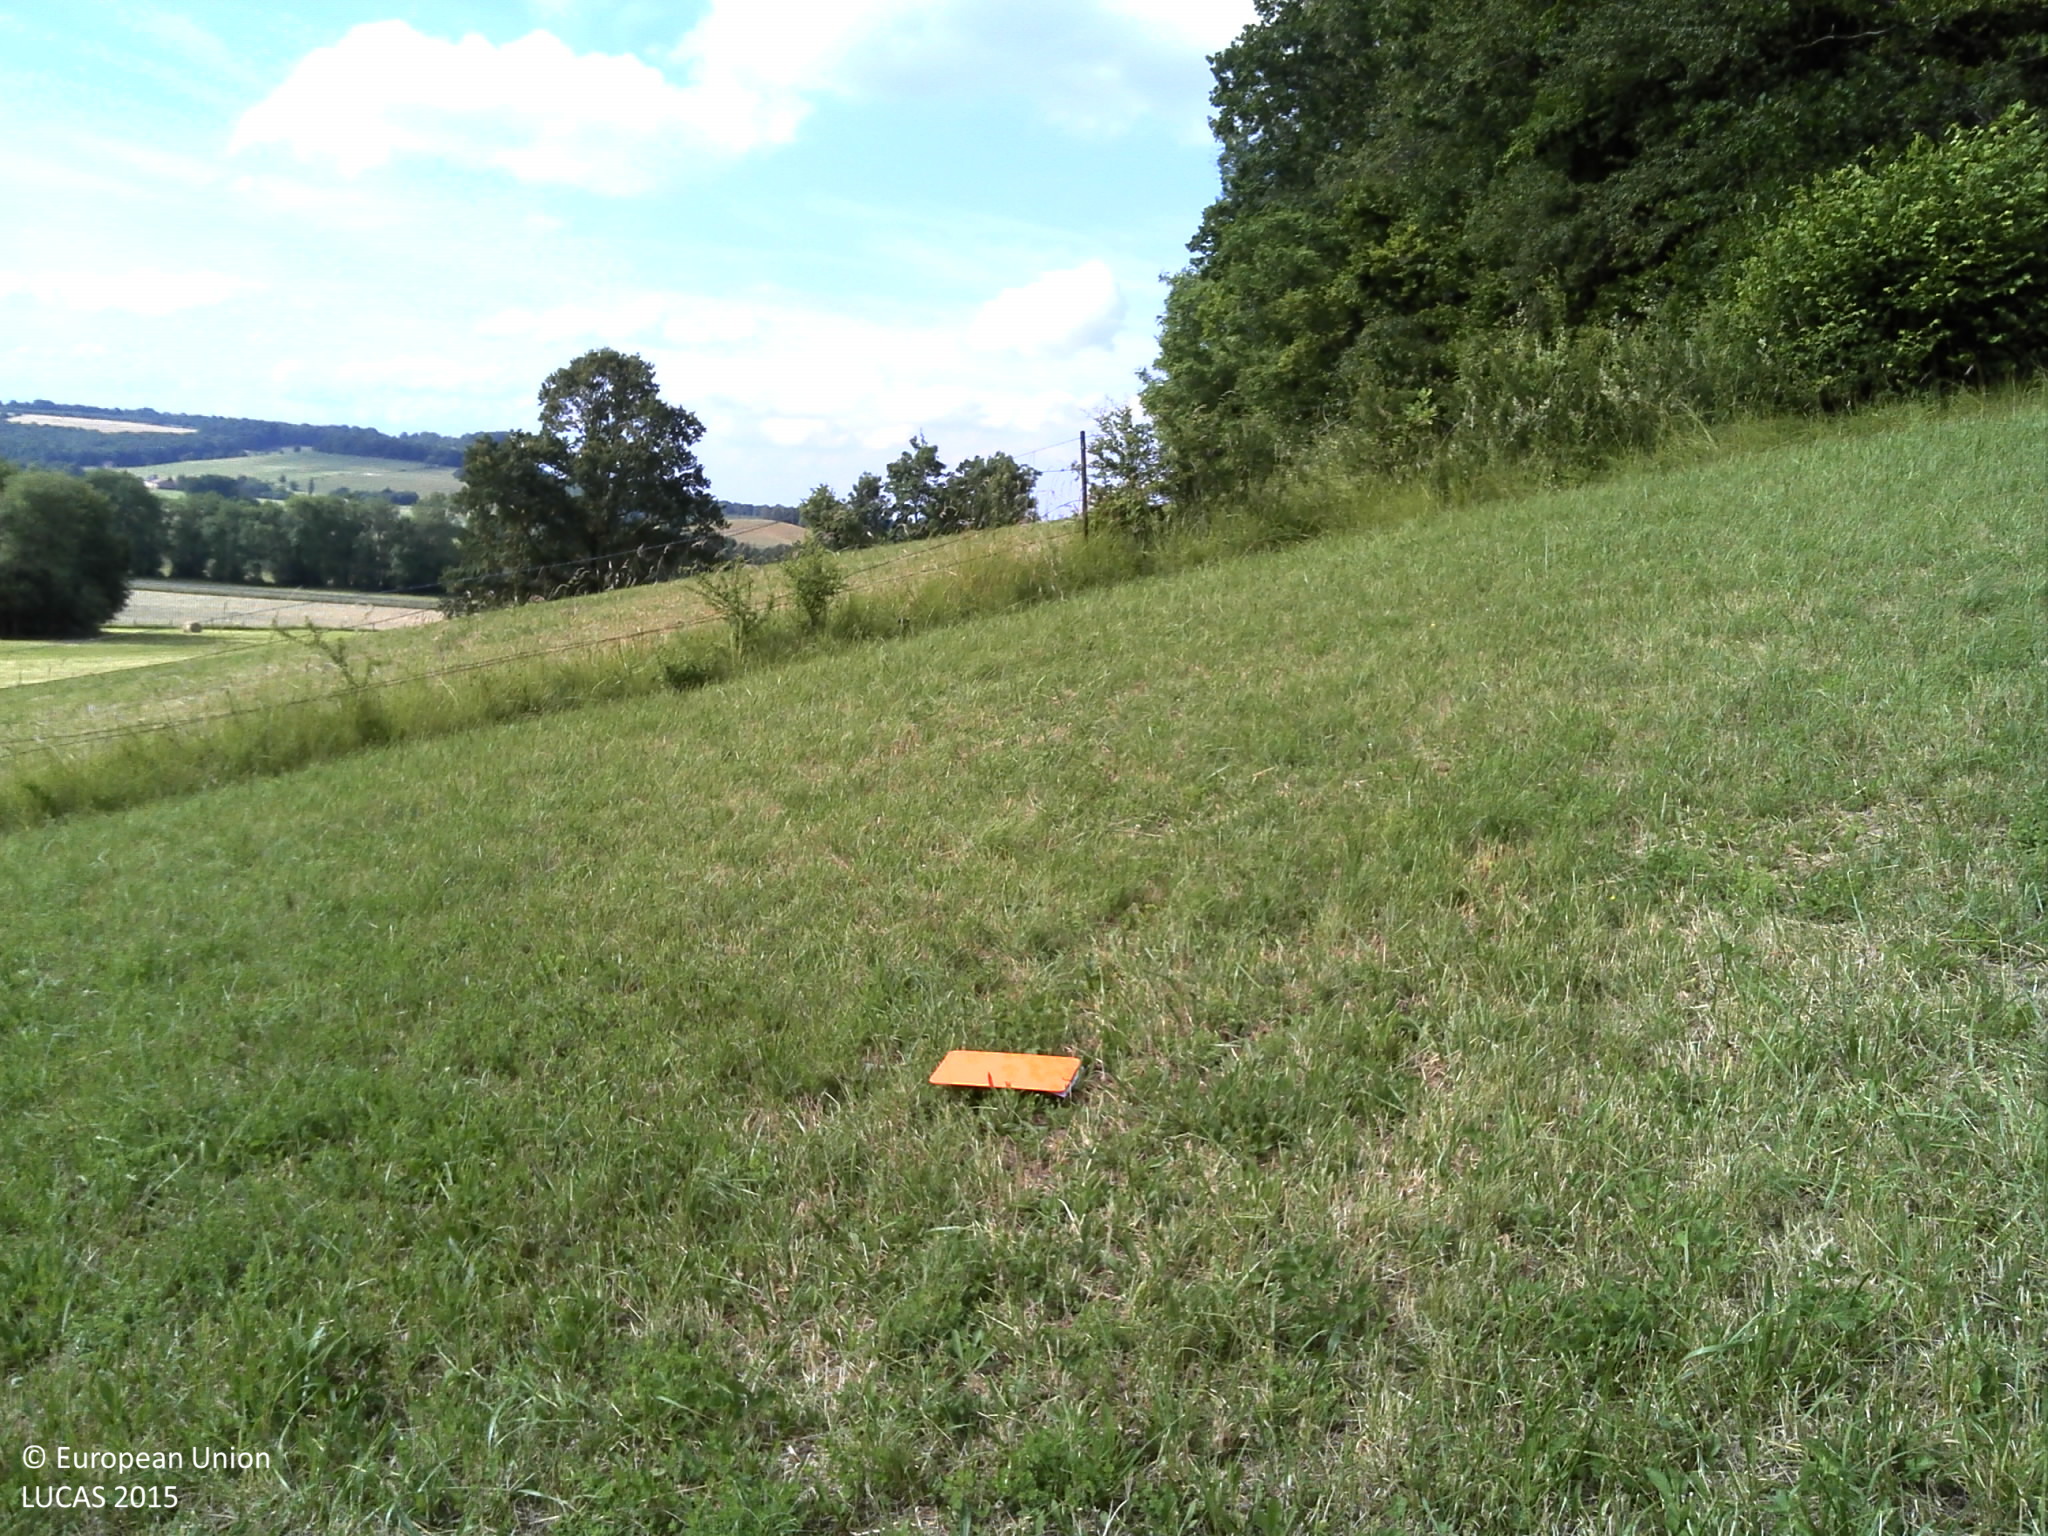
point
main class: Grassland
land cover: Grassland without tree/shrub cover
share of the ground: > 75 %
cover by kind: herbaceous plants 100 %
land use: Agriculture (excluding fallow land and kitchen gardens)
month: June
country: FR
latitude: 49.4472
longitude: 5.0736
